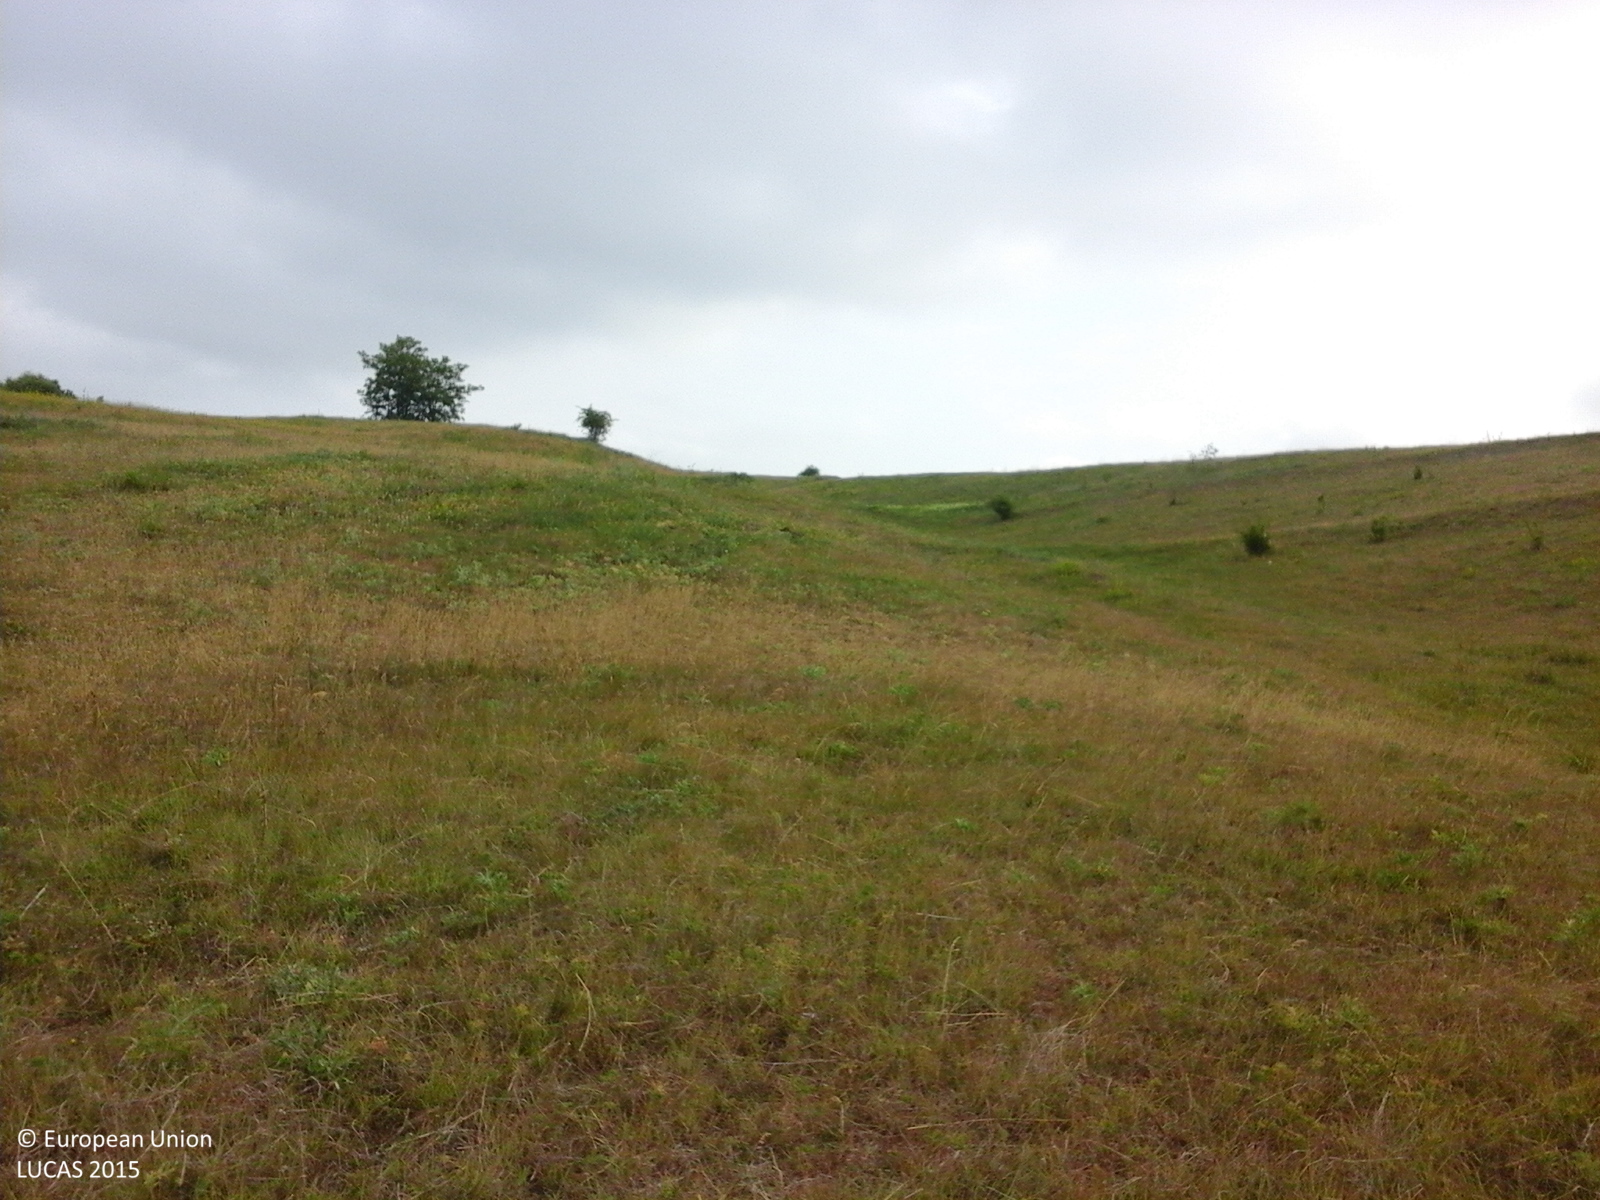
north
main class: Grassland
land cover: Grassland without tree/shrub cover
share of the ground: > 75 %
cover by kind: herbaceous plants 100 %
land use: Agriculture (excluding fallow land and kitchen gardens)
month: June
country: RO
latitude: 47.6531
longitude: 26.5882
